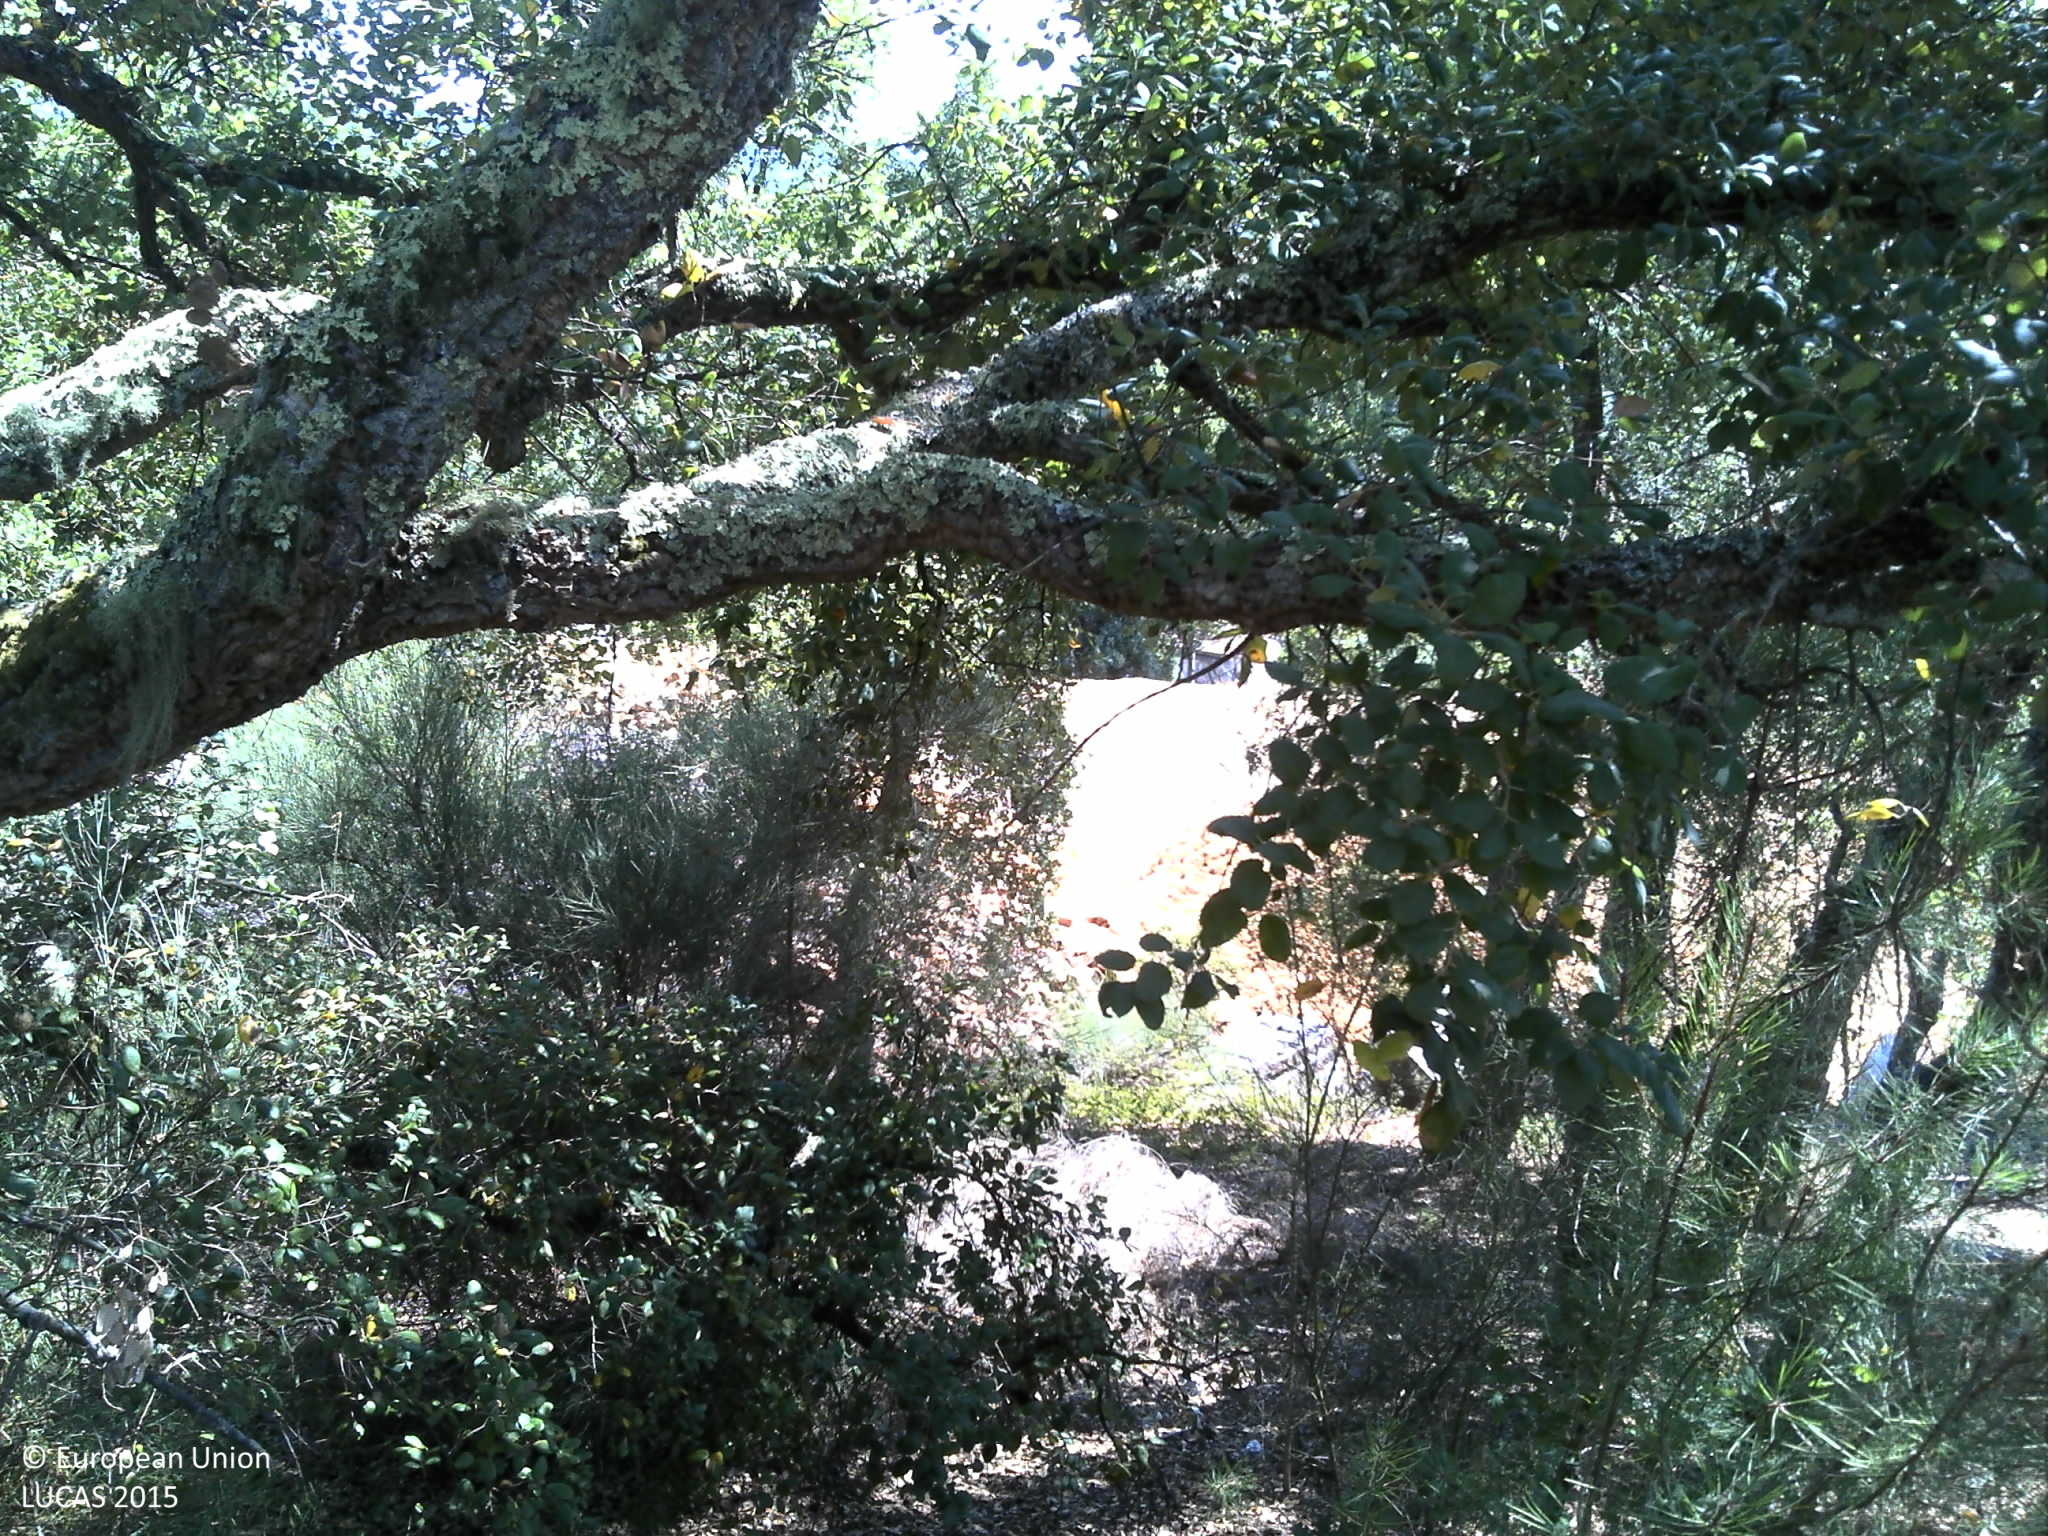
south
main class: Woodland
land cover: Broadleaved woodland
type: broadleaved evergreen forest
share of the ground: 10 - 25 %
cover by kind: shrubs 50 %, broadleaved forest trees 25 %, unconsolidated bare surface 25 %
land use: Forestry
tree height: > 5 m
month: July
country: PT
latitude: 39.9091
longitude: -8.1435
